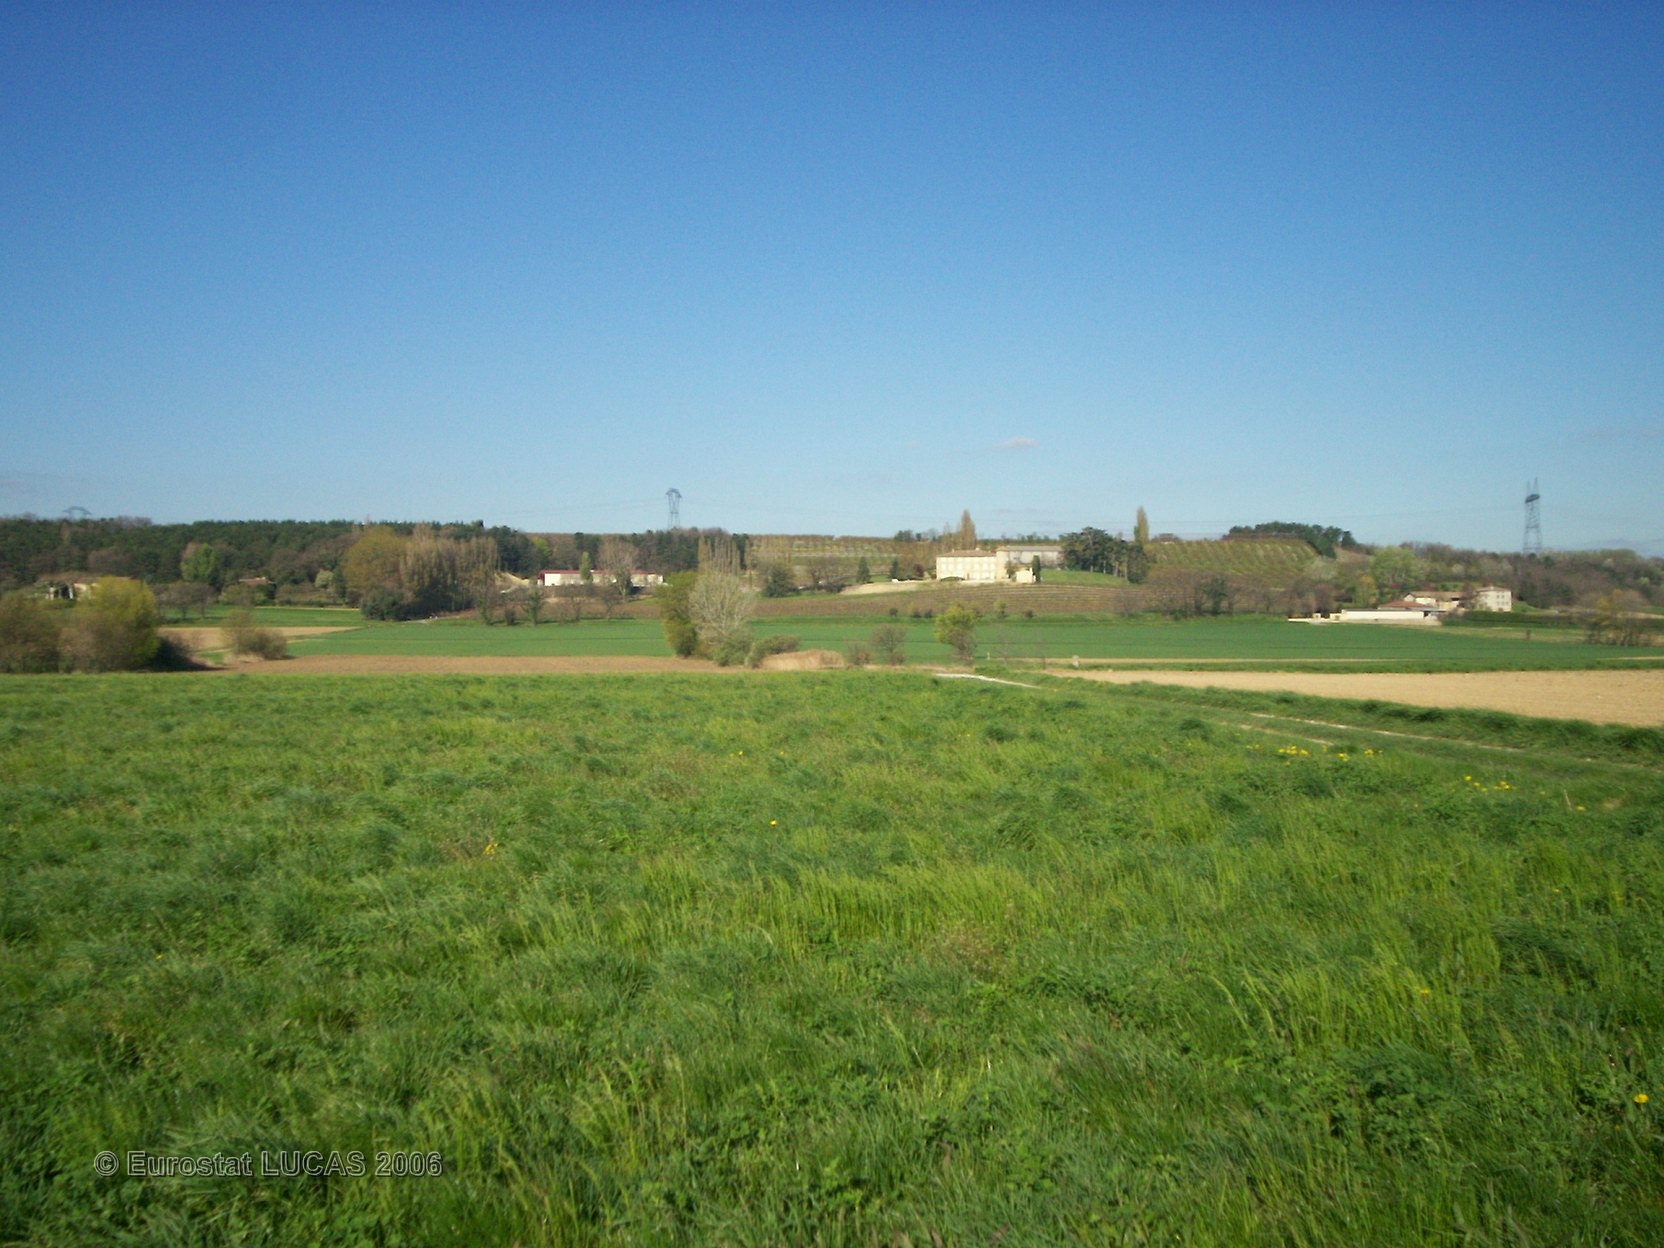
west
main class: Grassland
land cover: Grassland without tree/shrub cover
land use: Agriculture (excluding fallow land and kitchen gardens)
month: April
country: FR
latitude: 44.7858
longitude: 4.9127
